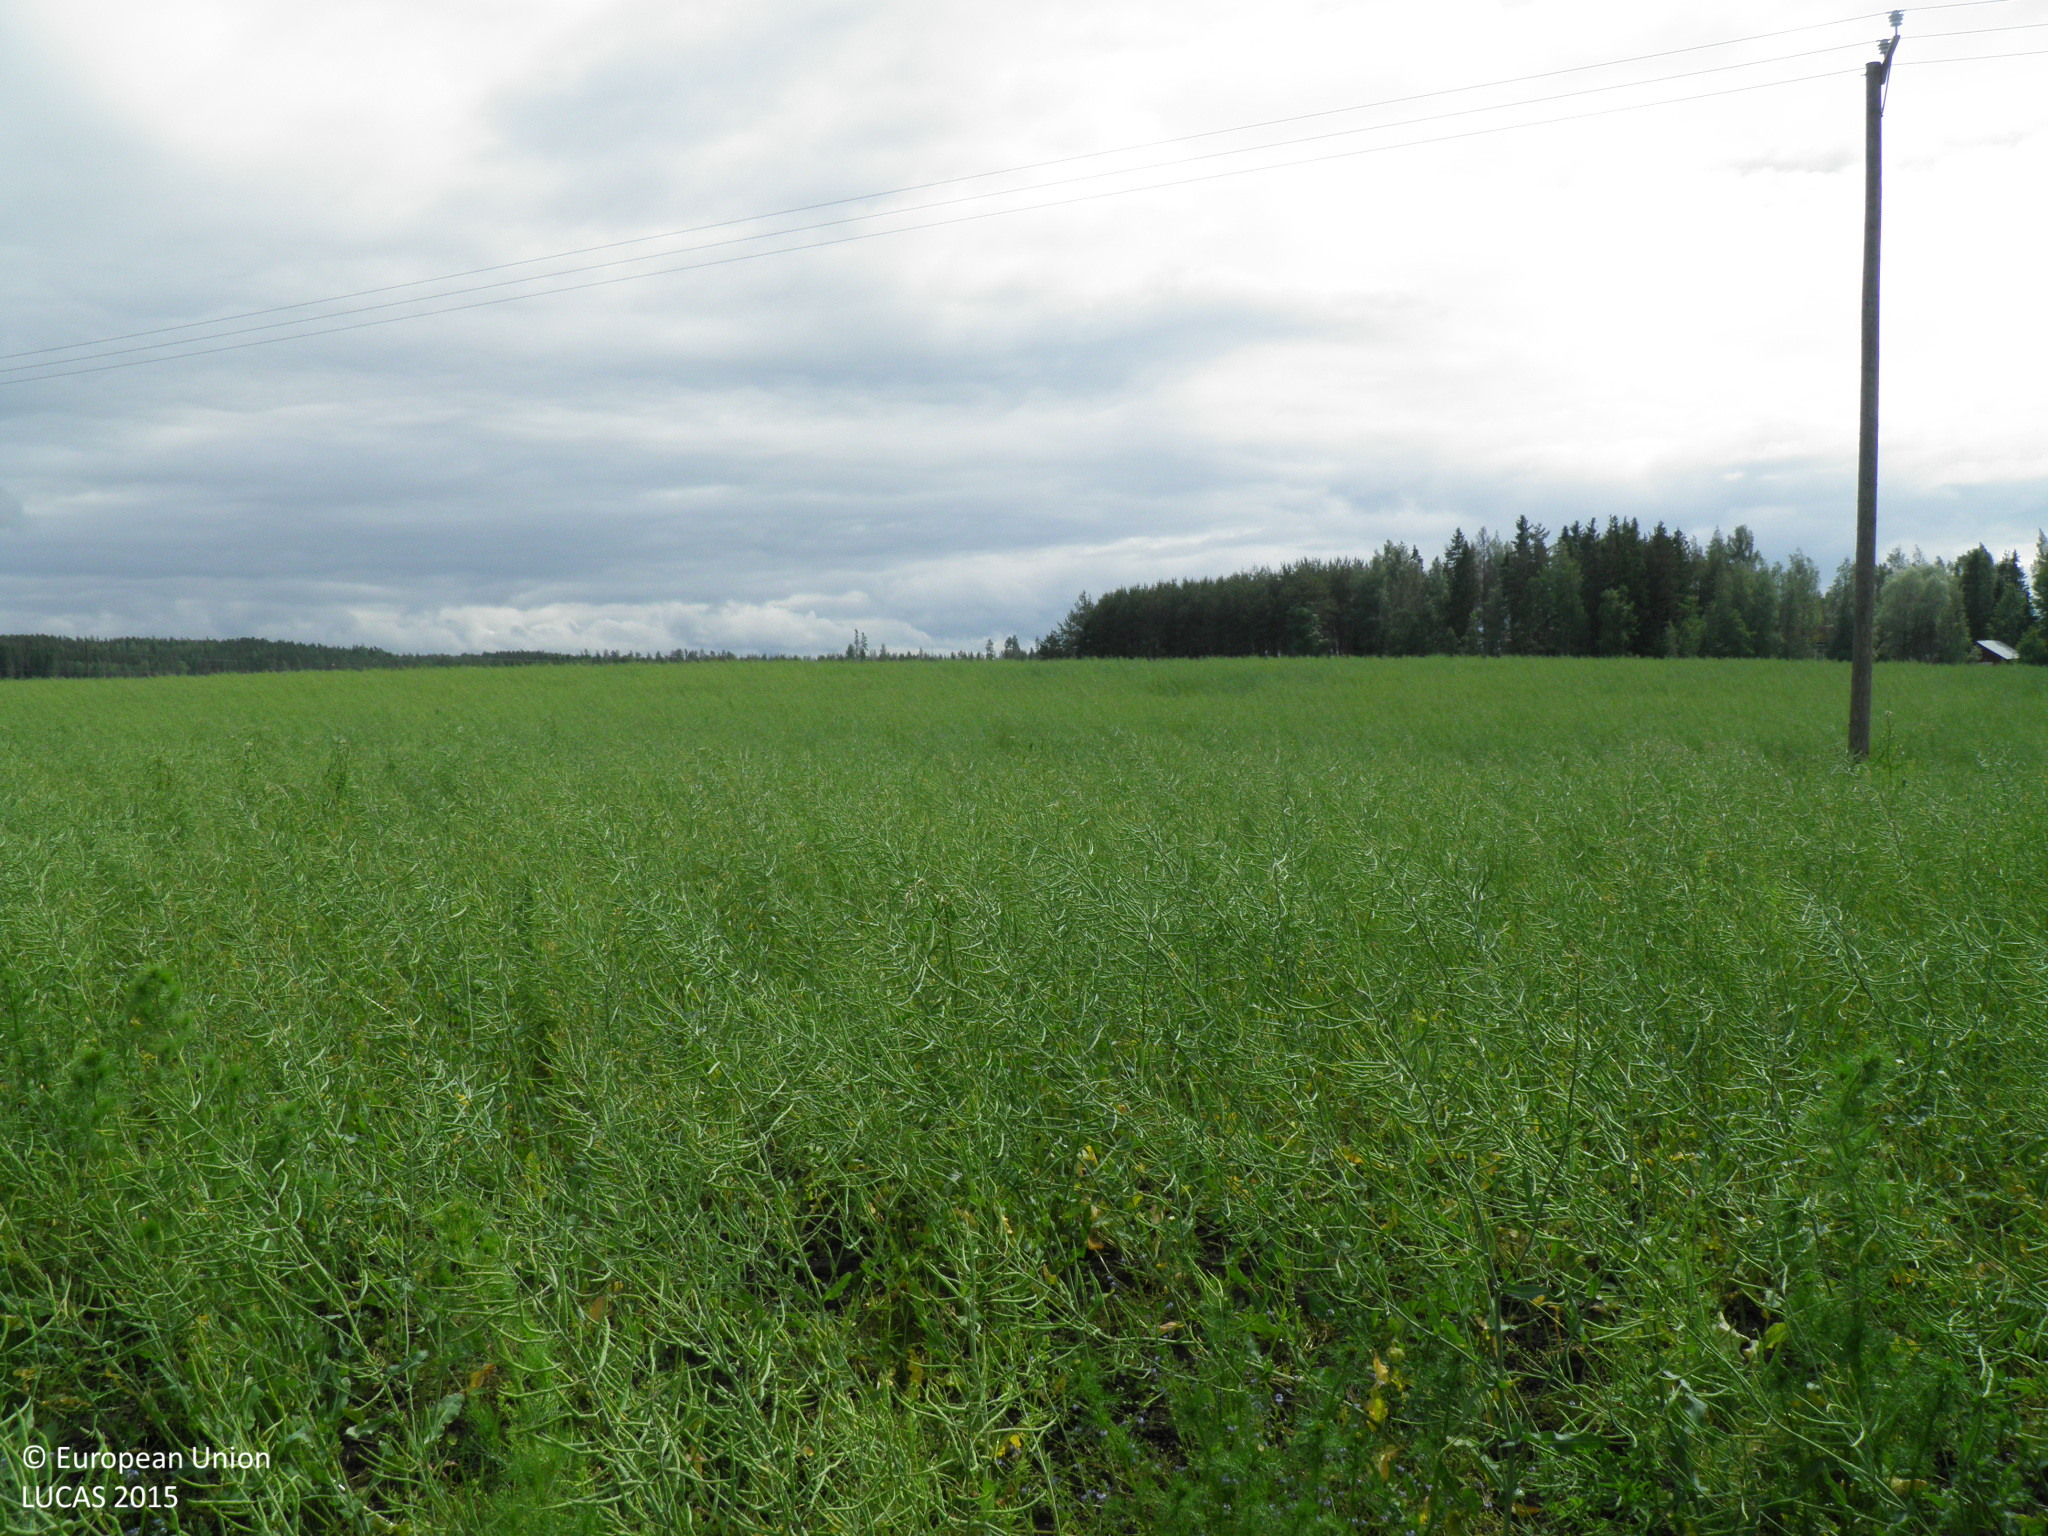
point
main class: Cropland
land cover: Rape and turnip rape
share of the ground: > 75 %
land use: Agriculture (excluding fallow land and kitchen gardens)
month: June
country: FI
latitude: 60.4099
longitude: 22.8760
